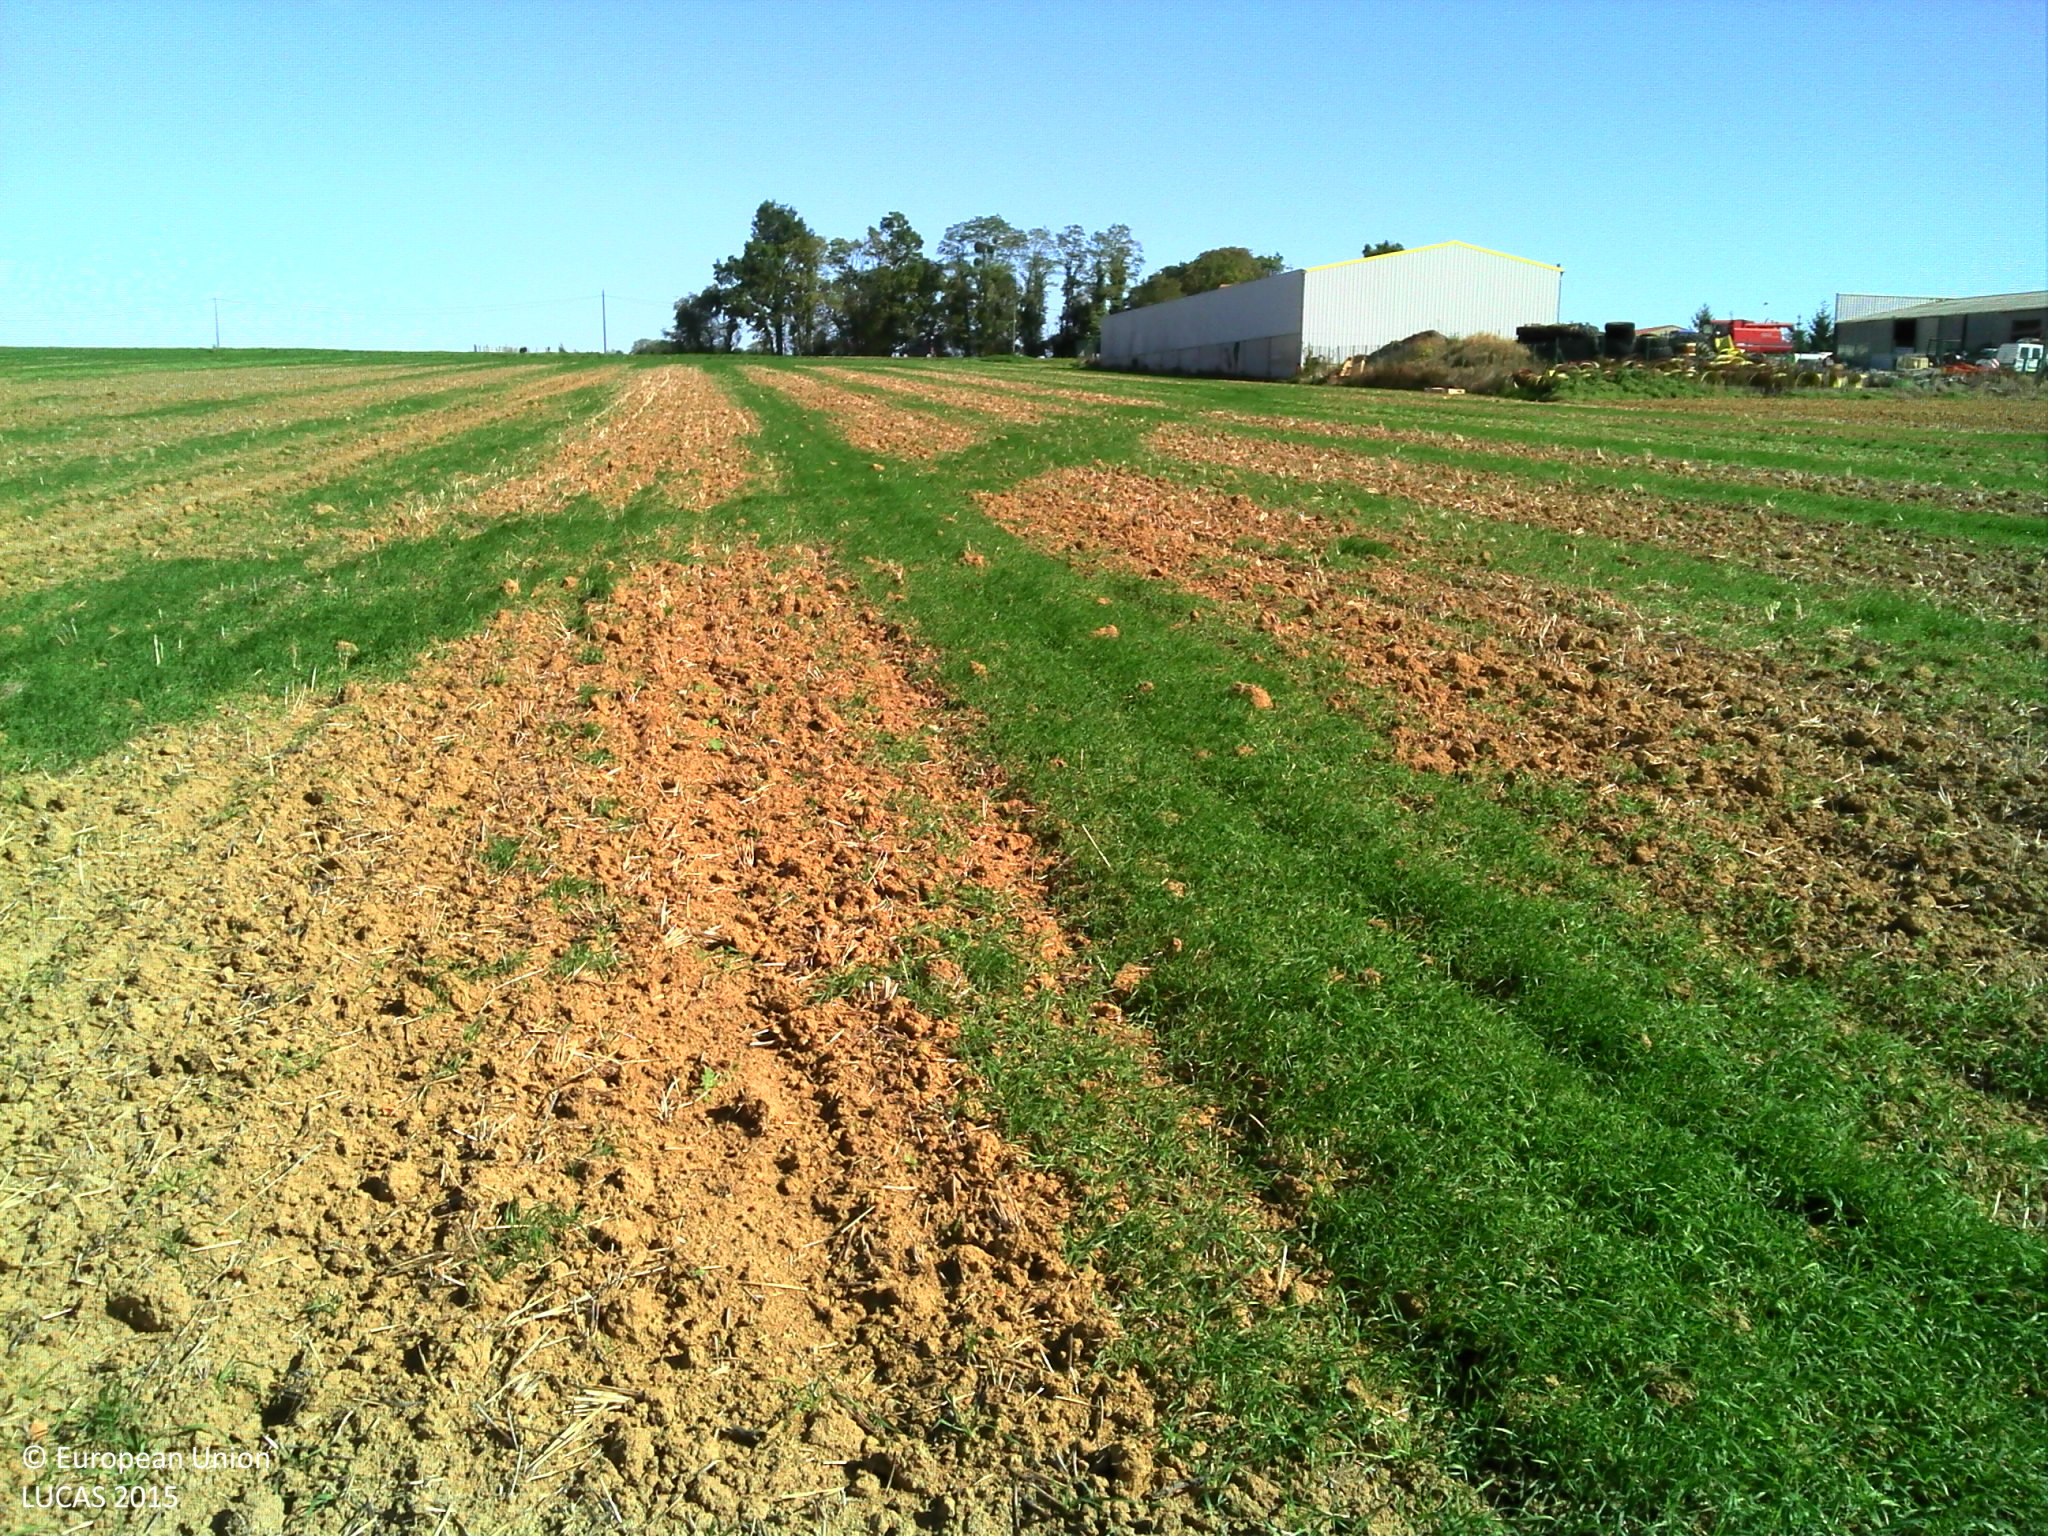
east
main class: Cropland
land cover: Common wheat
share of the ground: 10 - 25 %
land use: Agriculture (excluding fallow land and kitchen gardens)
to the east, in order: Common wheat; Grass margins; Paved roads, cycling and walking lanes; Grass margins; Abandoned hedges; Ditches and canals; Fences; Grassland without tree/shrub cover
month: September
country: FR
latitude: 48.3623
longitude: 4.6123
